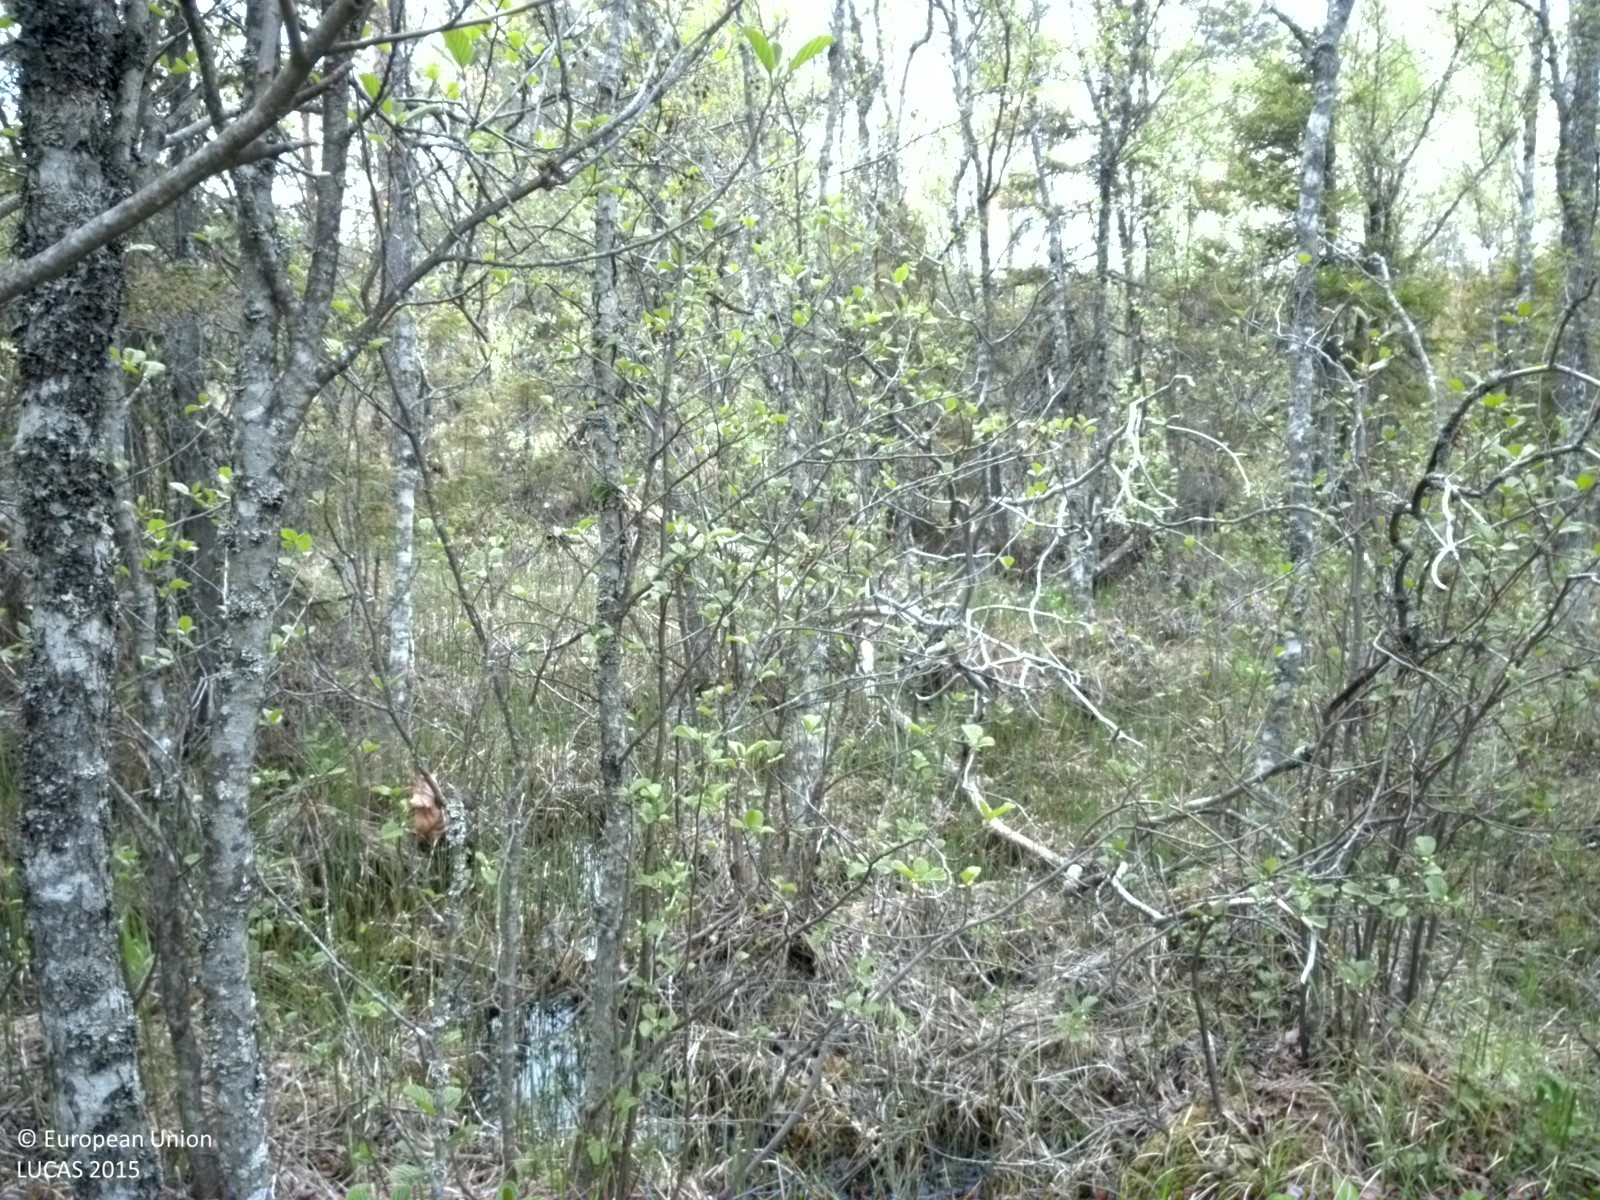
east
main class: Woodland
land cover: Spruce dominated mixed woodland
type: boreal forest
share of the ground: > 75 %
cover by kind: coniferous forest trees 40 %, broadleaved forest trees 40 %, herbaceous plants 15 %, shrubs 5 %
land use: Forestry
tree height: > 5 m
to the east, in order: Spruce dominated mixed woodland; Inland marshes; Grassland with sparse tree/shrub cover; Pine dominated coniferous woodland; Broadleaved woodland
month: May
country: SE
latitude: 60.2928
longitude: 18.0804
